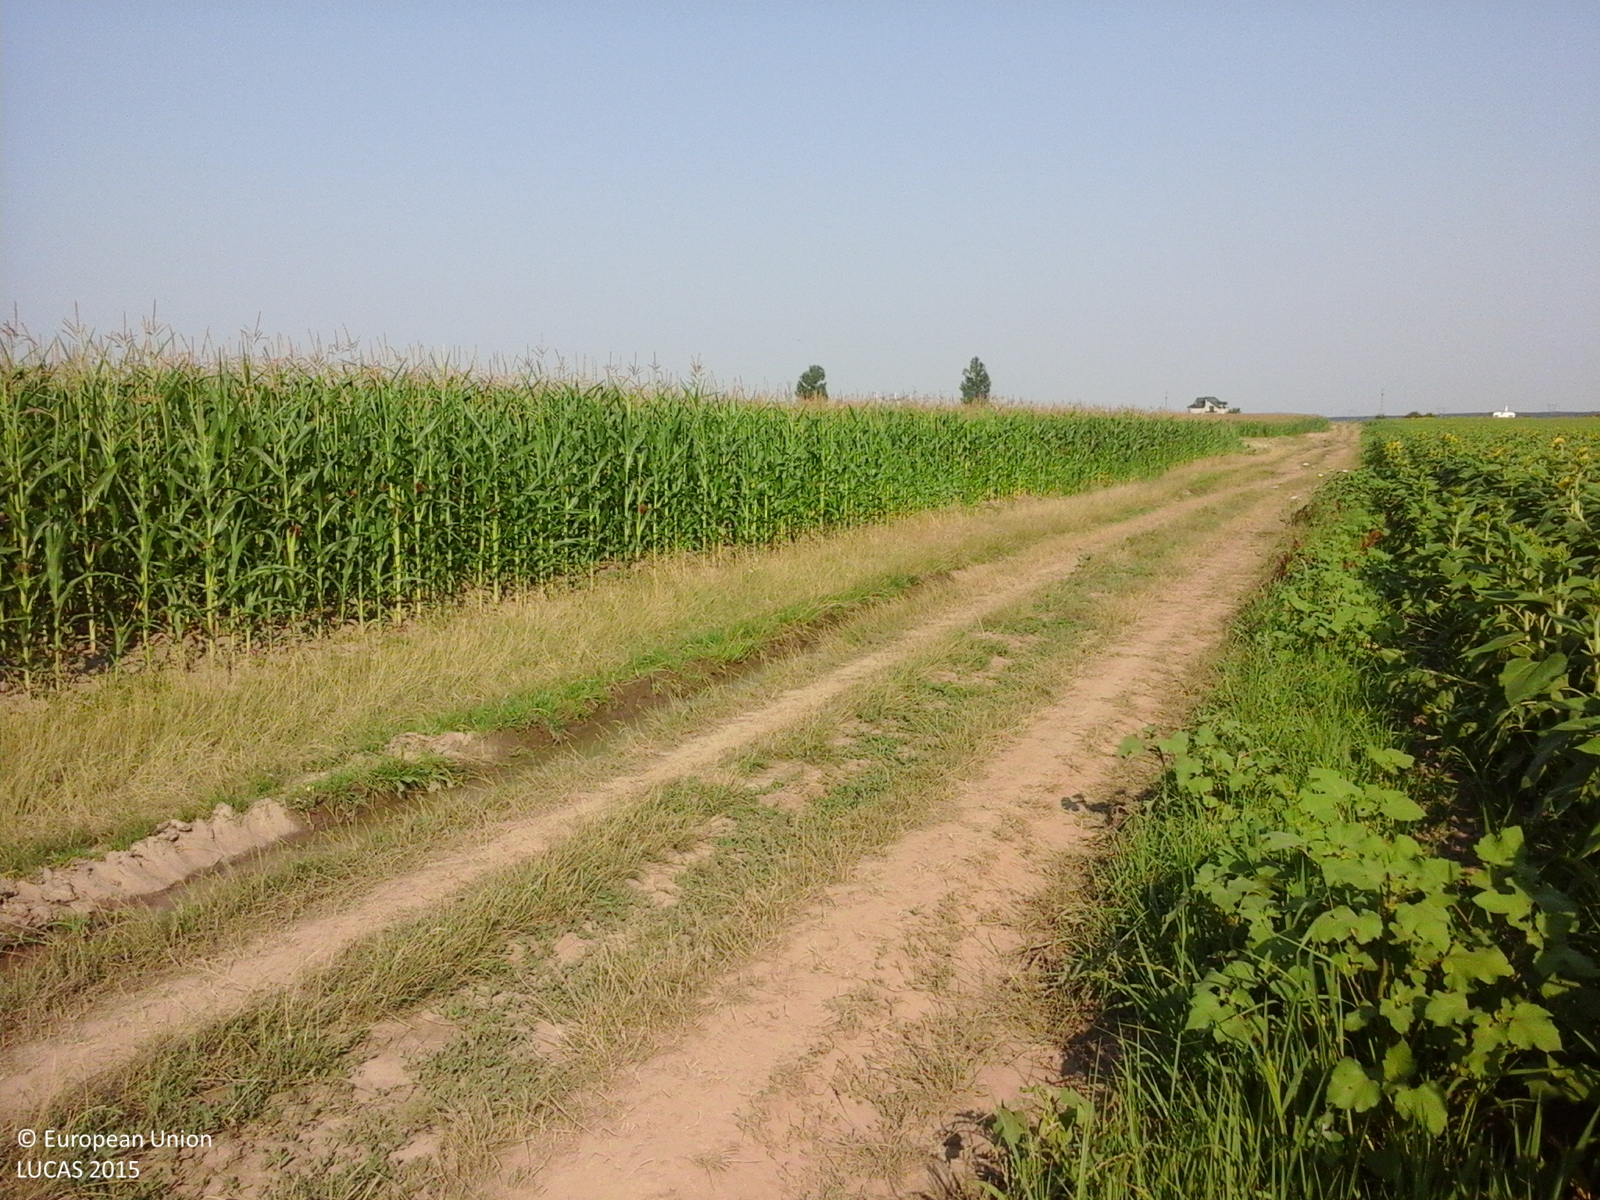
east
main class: Cropland
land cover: Sunflower
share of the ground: > 75 %
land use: Agriculture (excluding fallow land and kitchen gardens)
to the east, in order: Sunflower; Tracks; Maize
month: July
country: RO
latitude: 44.5452
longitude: 25.3053
